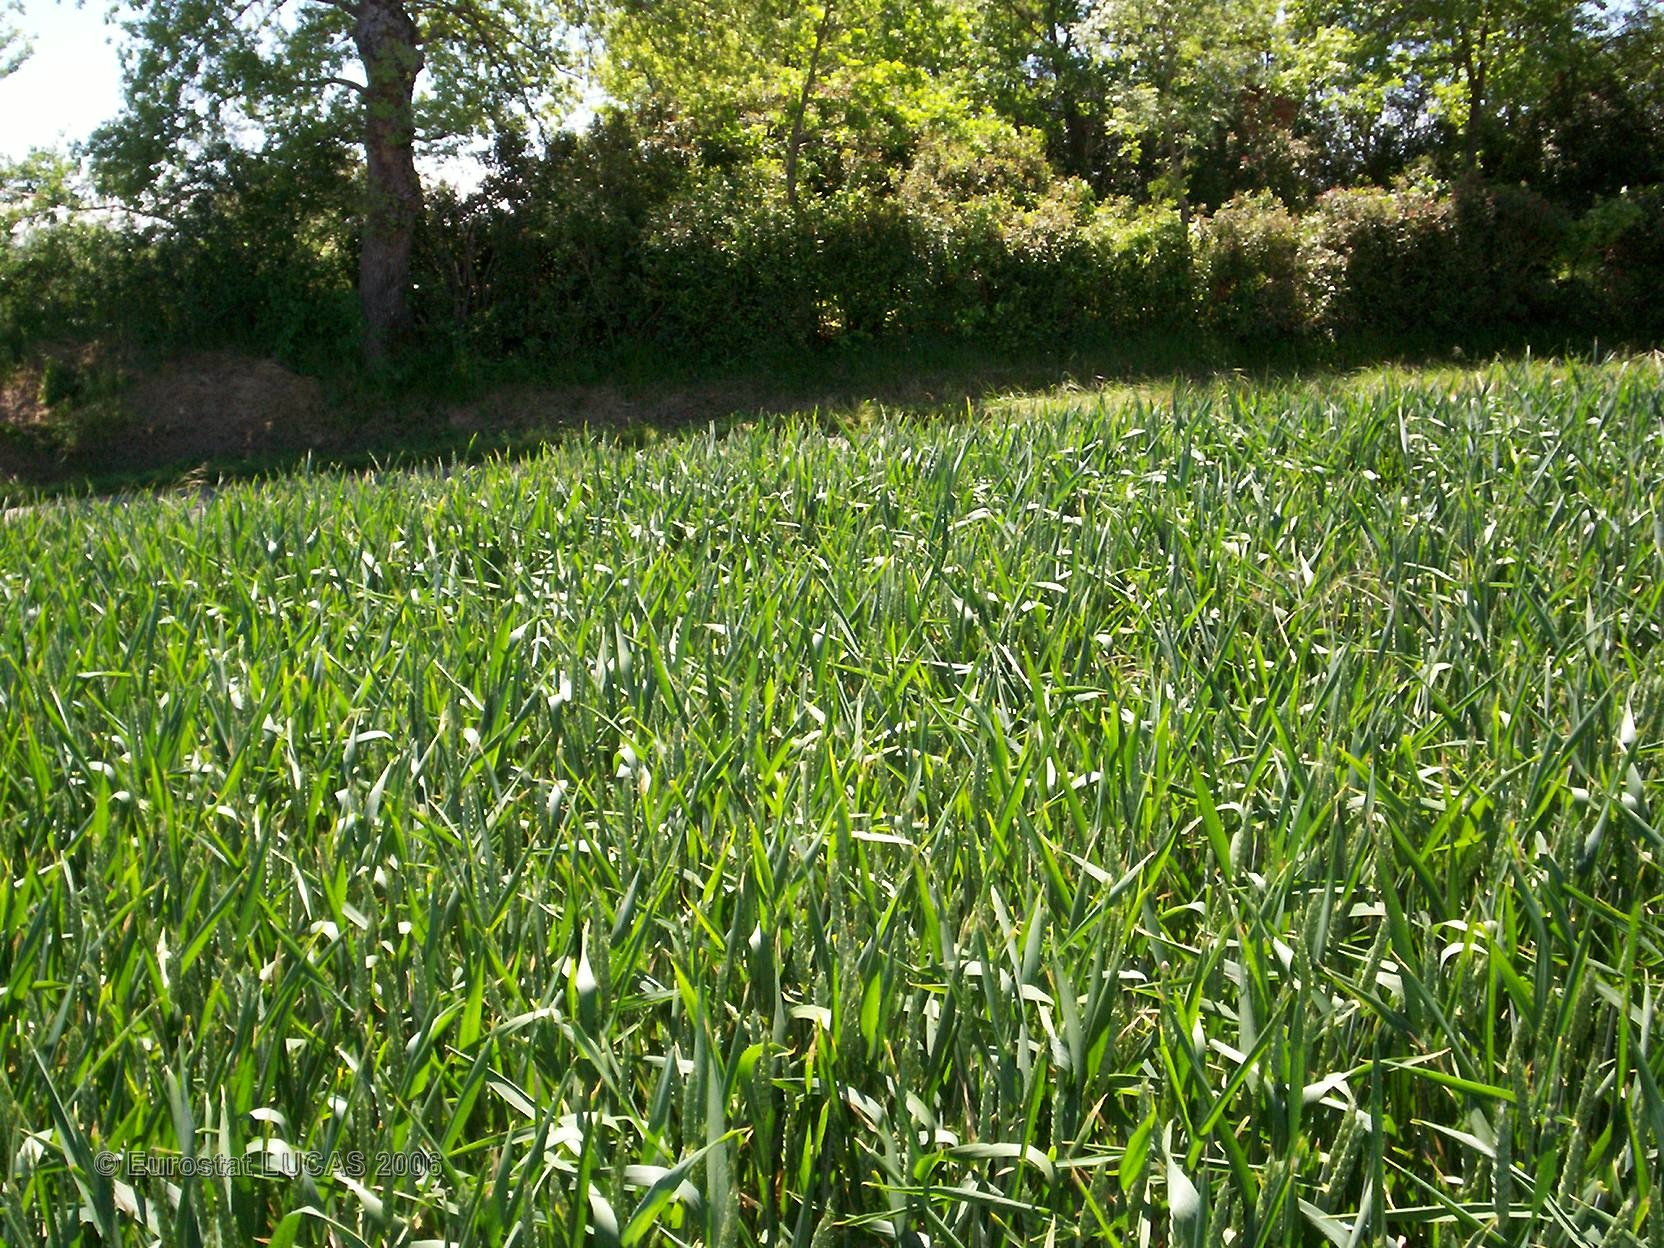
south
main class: Cropland
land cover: Durum wheat
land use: Agriculture (excluding fallow land and kitchen gardens)
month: May
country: FR
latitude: 43.4572
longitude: 0.8674
